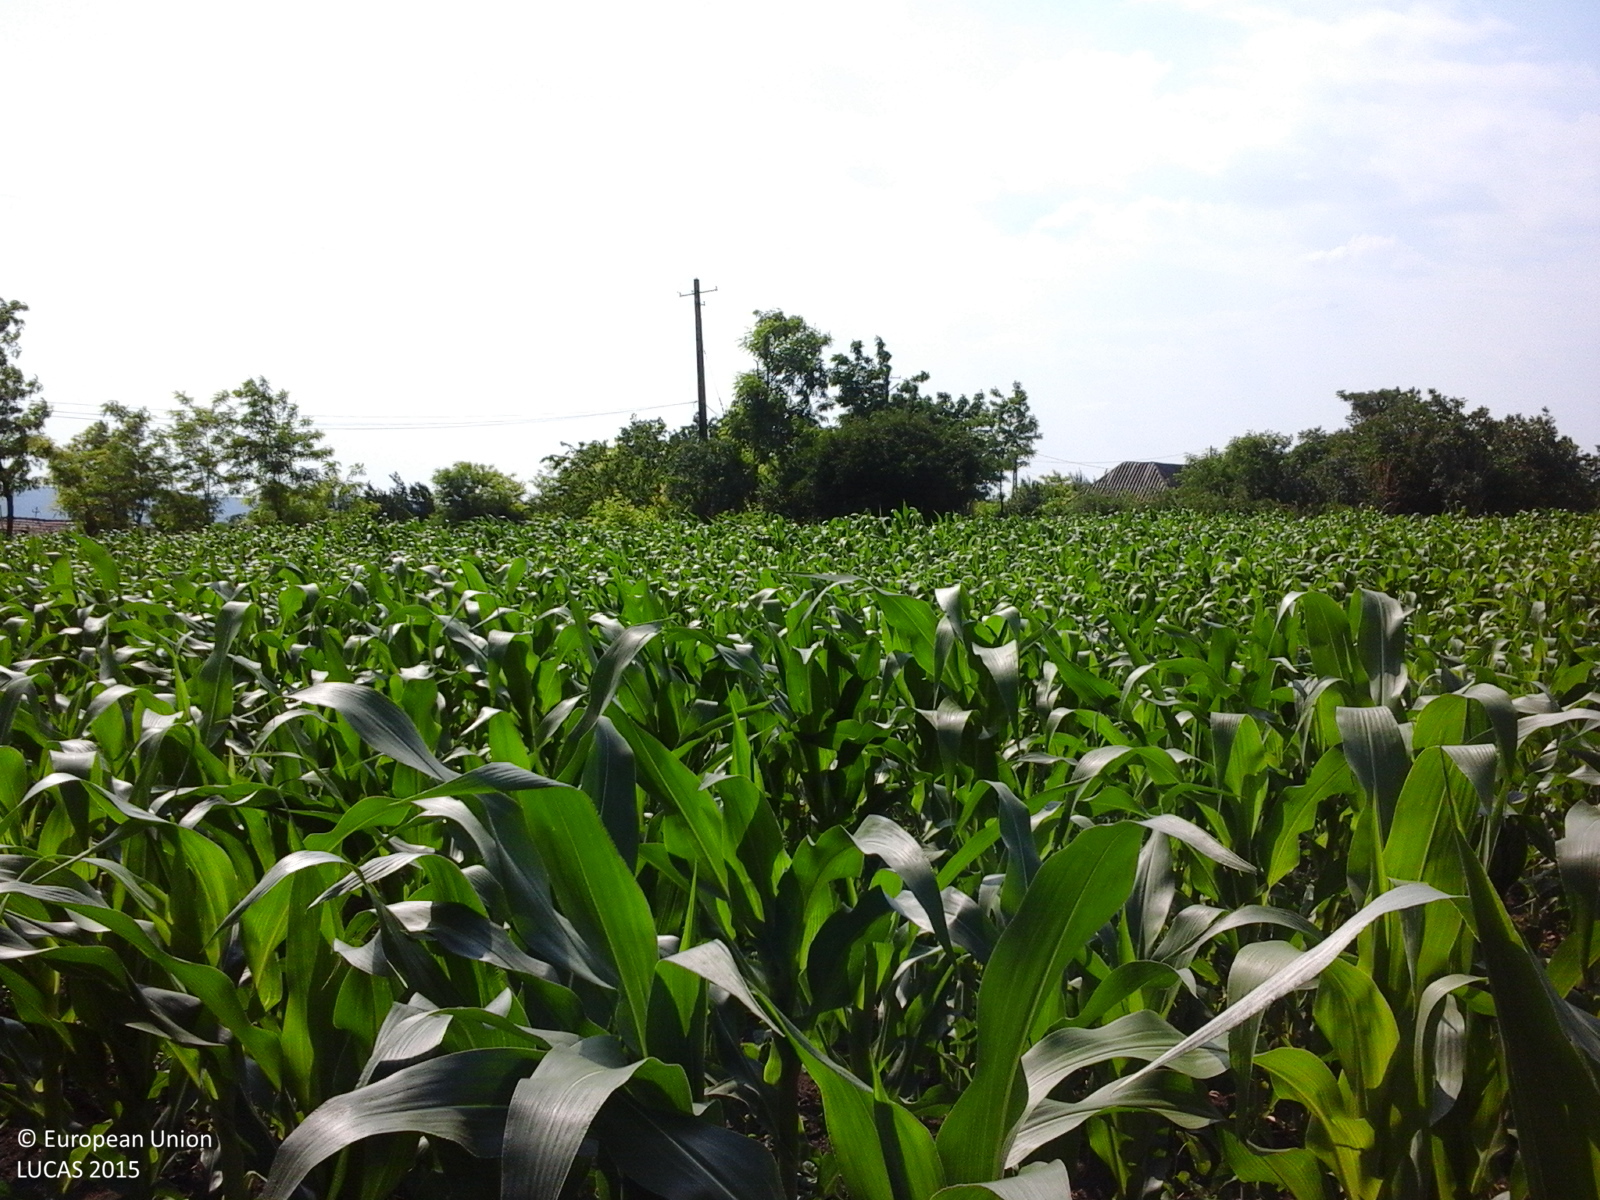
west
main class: Cropland
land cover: Maize
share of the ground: > 75 %
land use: Agriculture (excluding fallow land and kitchen gardens)
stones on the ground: < 10 %
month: June
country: RO
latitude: 47.3261
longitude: 27.4899
